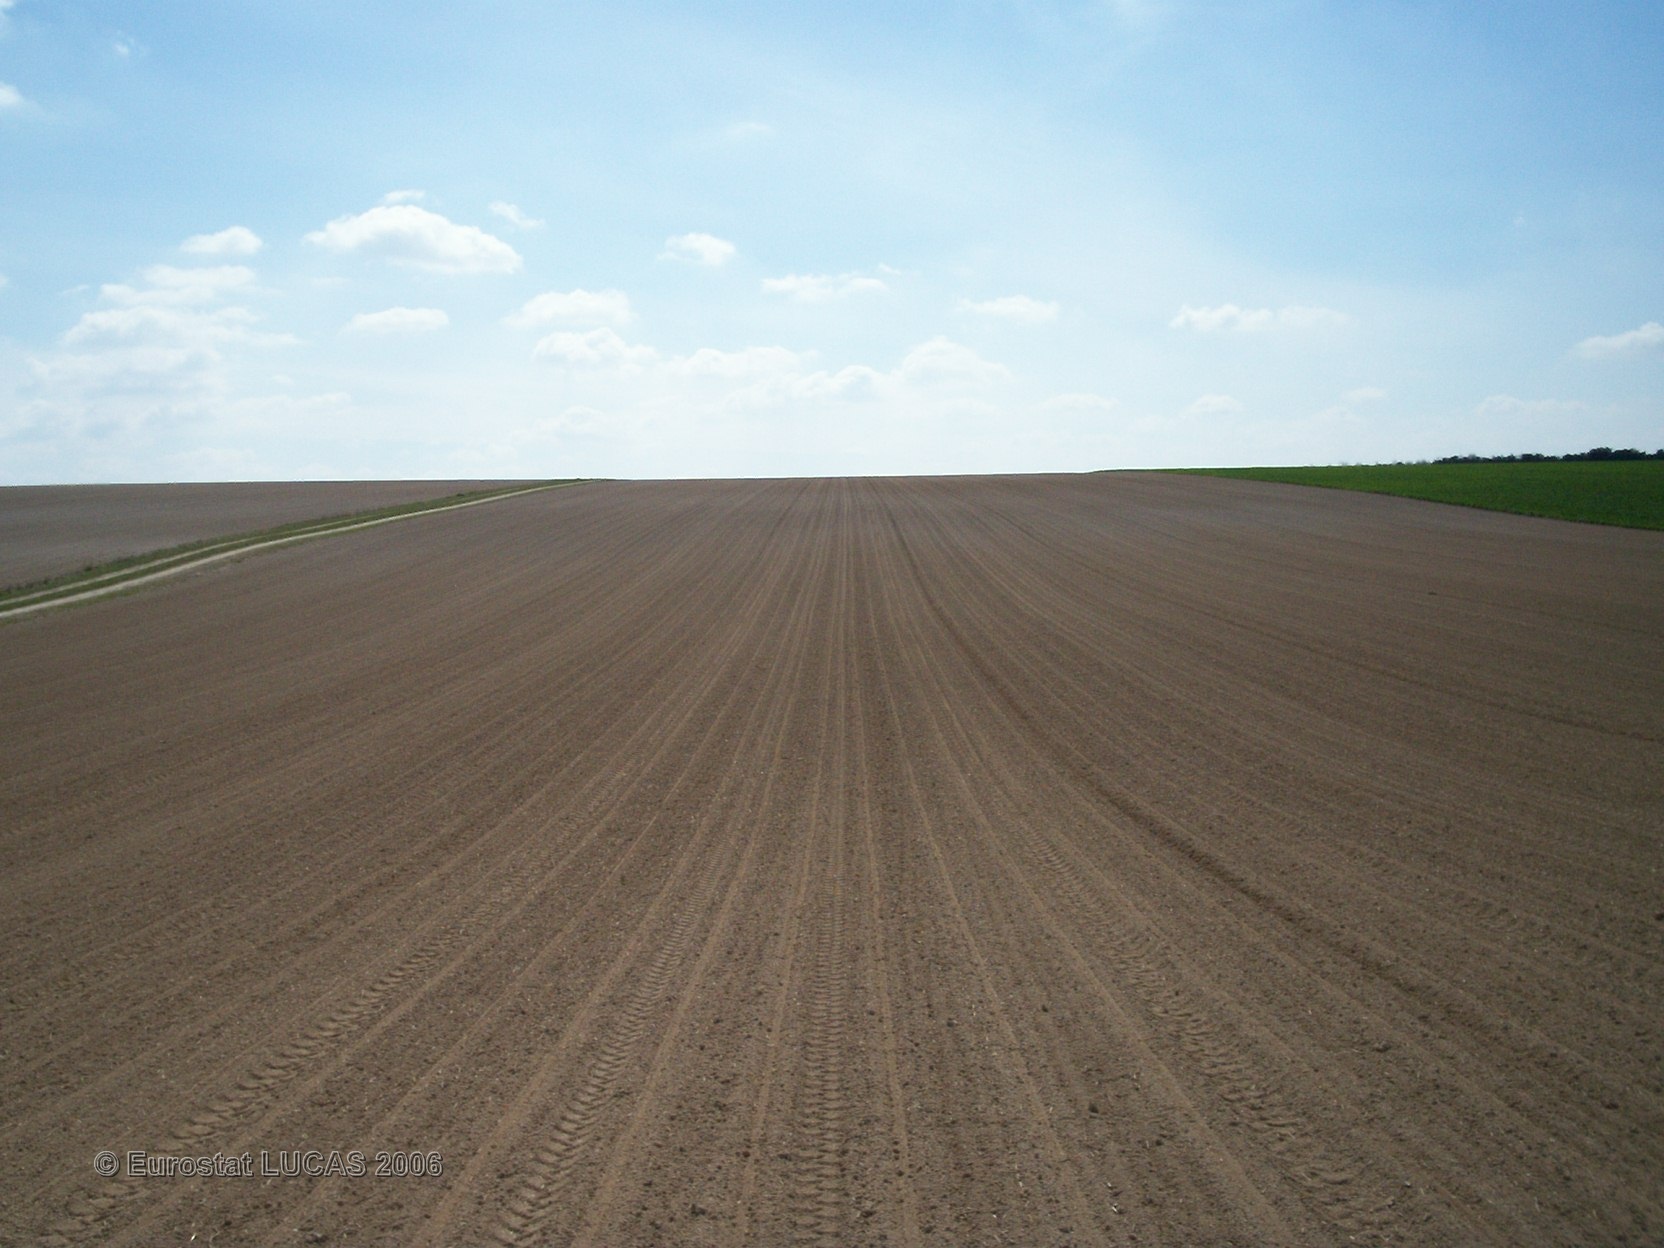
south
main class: Cropland
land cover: Sugar beet
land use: Agriculture (excluding fallow land and kitchen gardens)
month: June
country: FR
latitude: 49.2343
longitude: 4.3791
